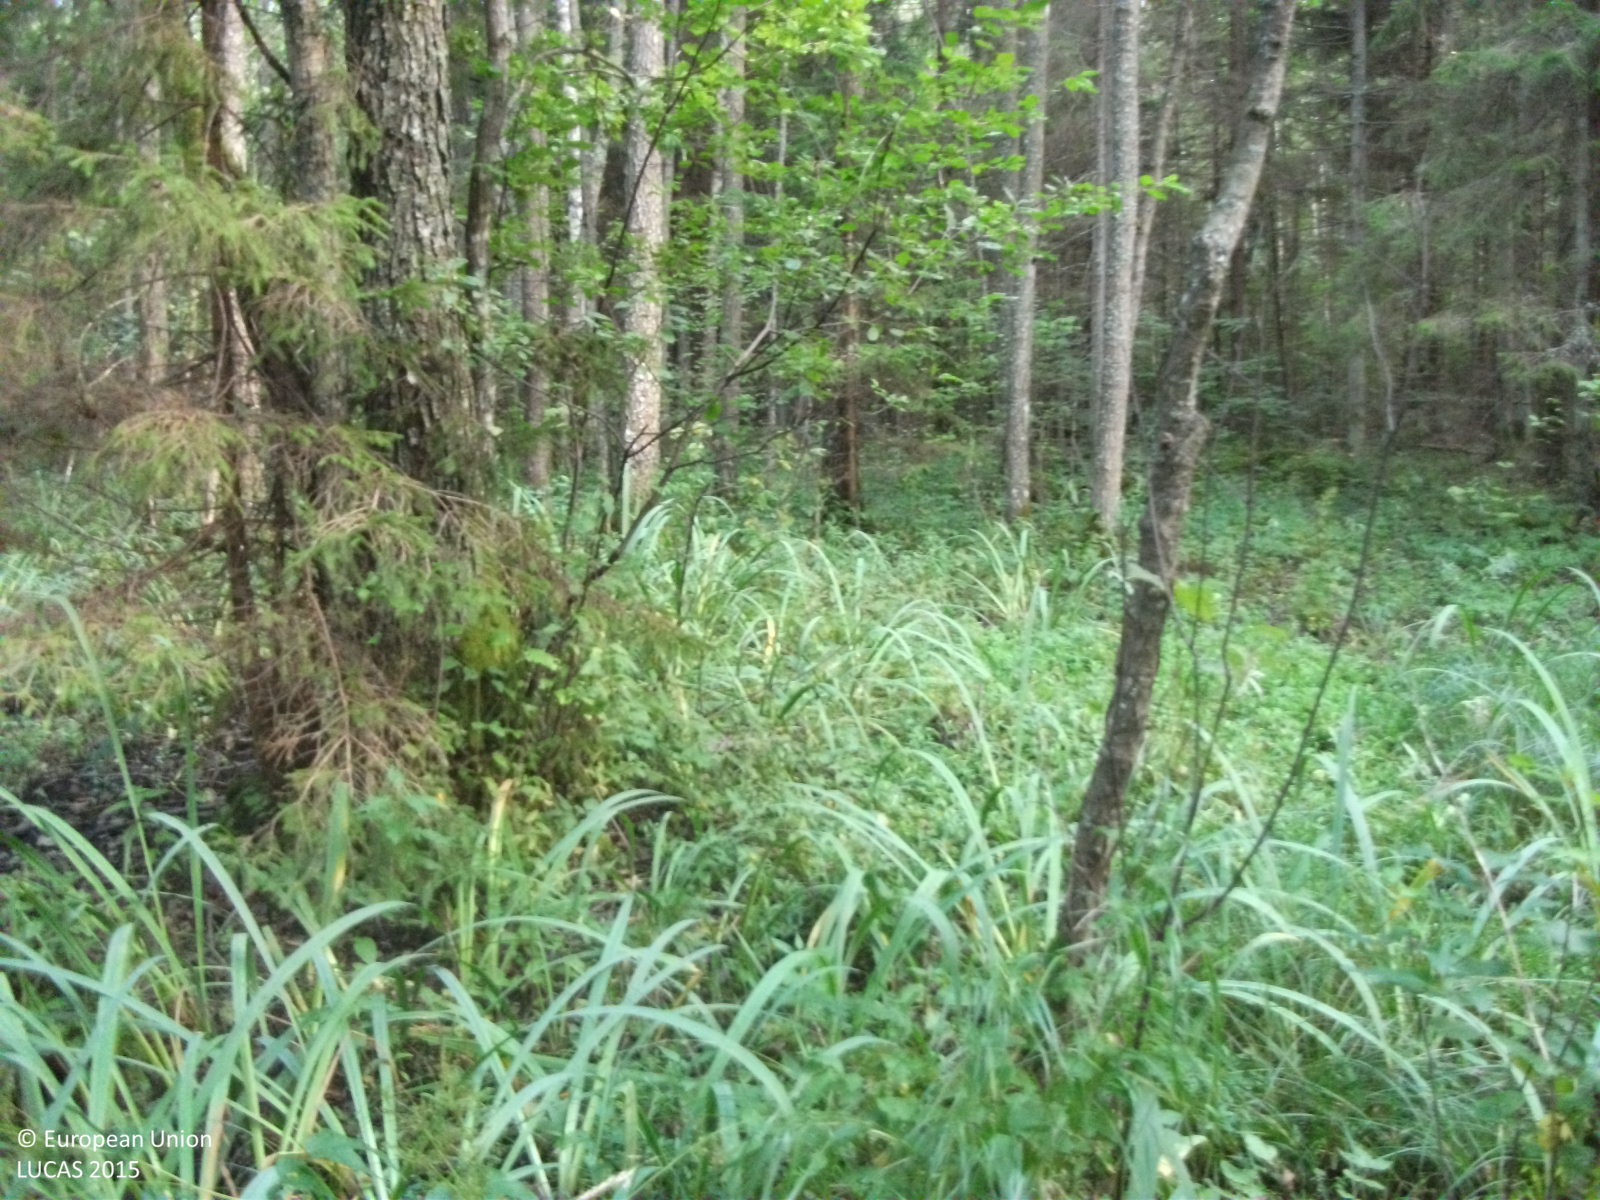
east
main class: Woodland
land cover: Other mixed woodland
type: hemiboreal forest and nemoral coniferous forest and mixed broadleaved-coniferous forest
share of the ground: 50 - 75 %
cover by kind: broadleaved forest trees 50 %, coniferous forest trees 20 %, herbaceous plants 20 %, shrubs 5 %, lichens and mosses 5 %
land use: Forestry
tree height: > 5 m
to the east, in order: Other mixed woodland; Broadleaved woodland; Other mixed woodland; Broadleaved woodland; Other mixed woodland; Broadleaved woodland; Electric lines; Broadleaved woodland
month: September
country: LV
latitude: 57.5683
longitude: 24.3824
